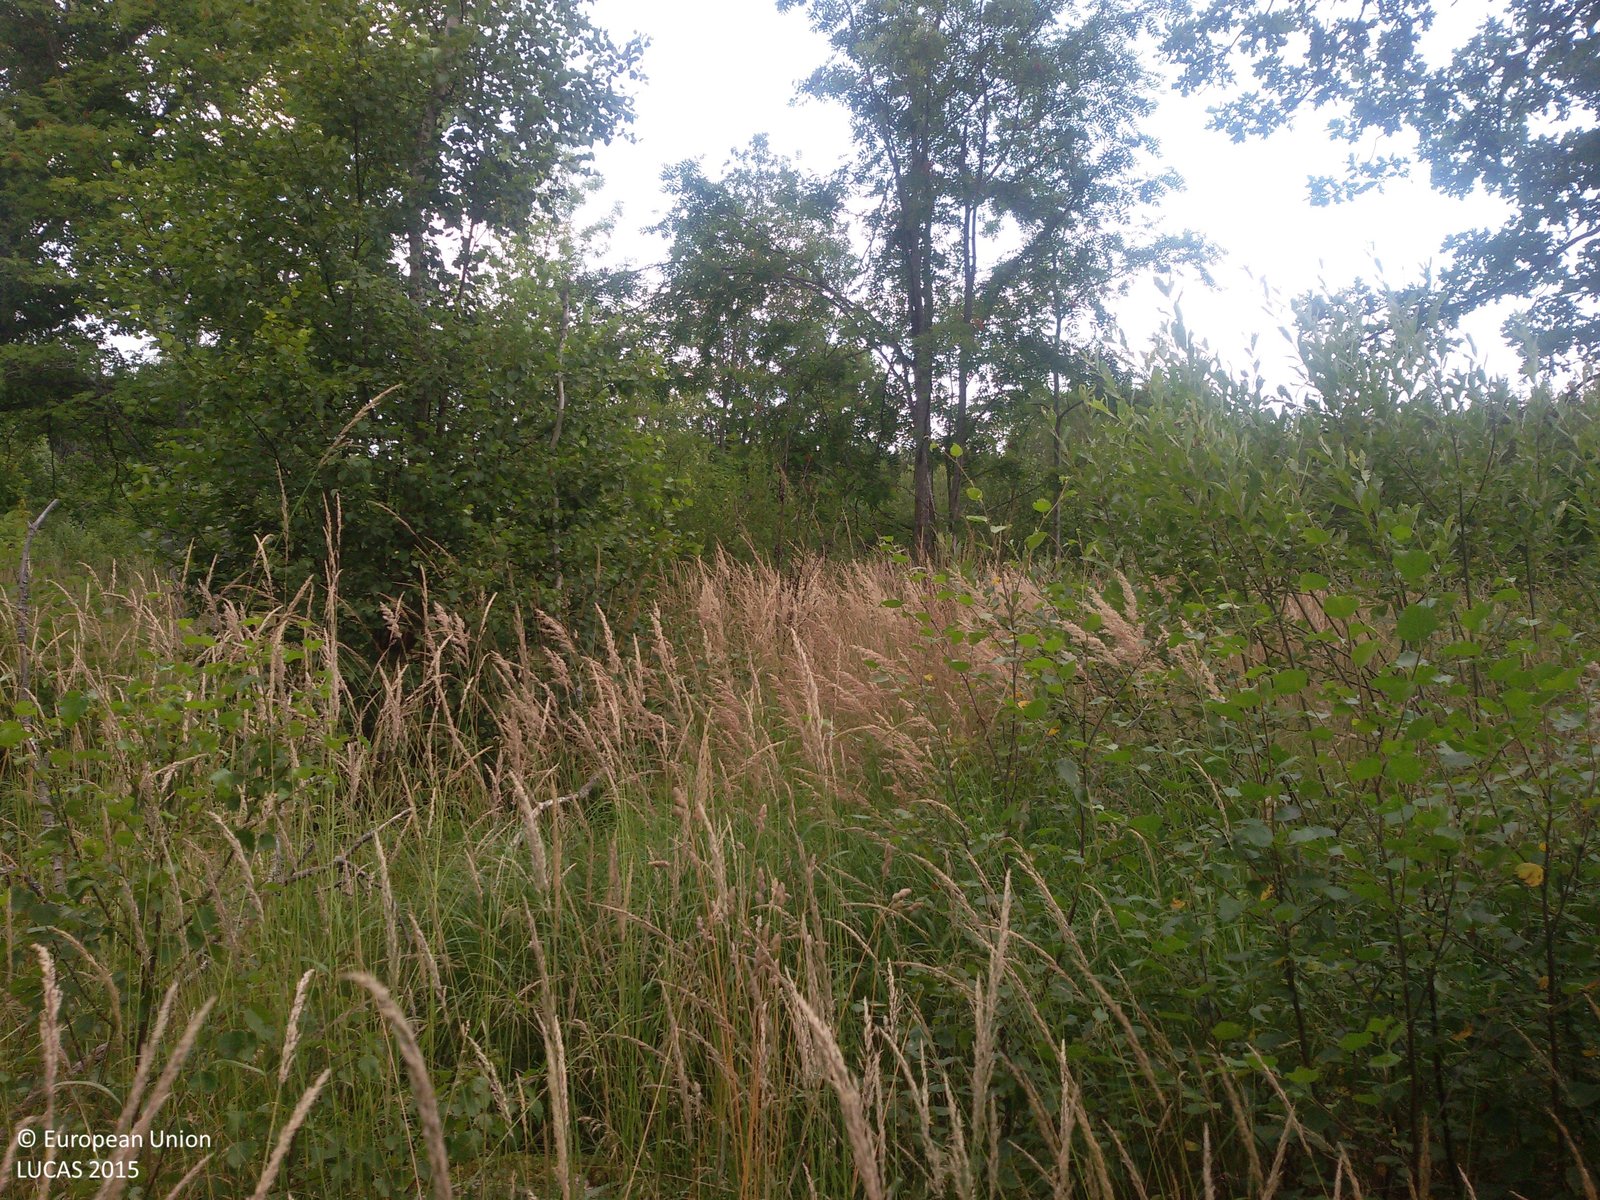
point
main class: Woodland
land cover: Broadleaved woodland
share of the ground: 25 - 50 %
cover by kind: herbaceous plants 50 %, broadleaved forest trees 30 %, shrubs 20 %
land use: Semi-natural and natural areas not in use
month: August
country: SE
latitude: 60.5337
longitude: 16.5675
